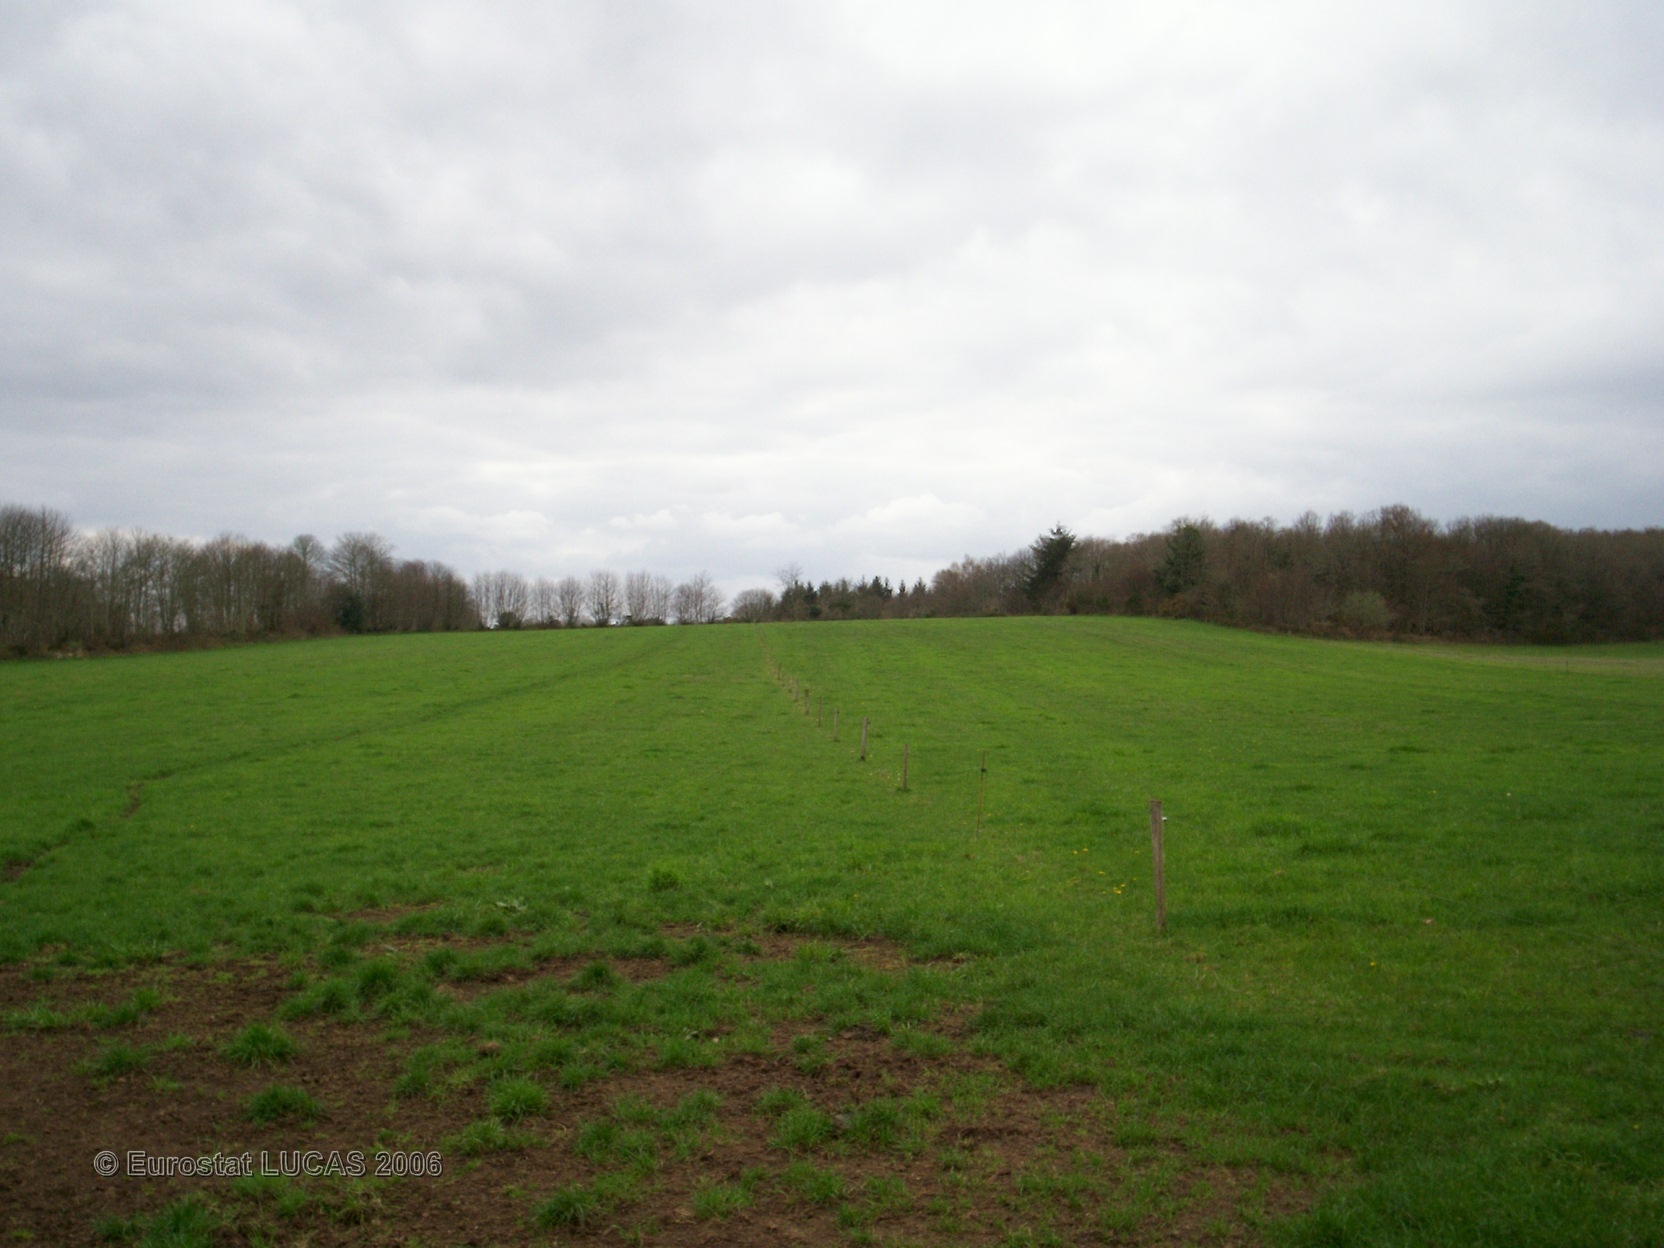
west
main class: Grassland
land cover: Grassland without tree/shrub cover
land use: Agriculture (excluding fallow land and kitchen gardens)
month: April
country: FR
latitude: 47.9530
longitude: -3.5071
